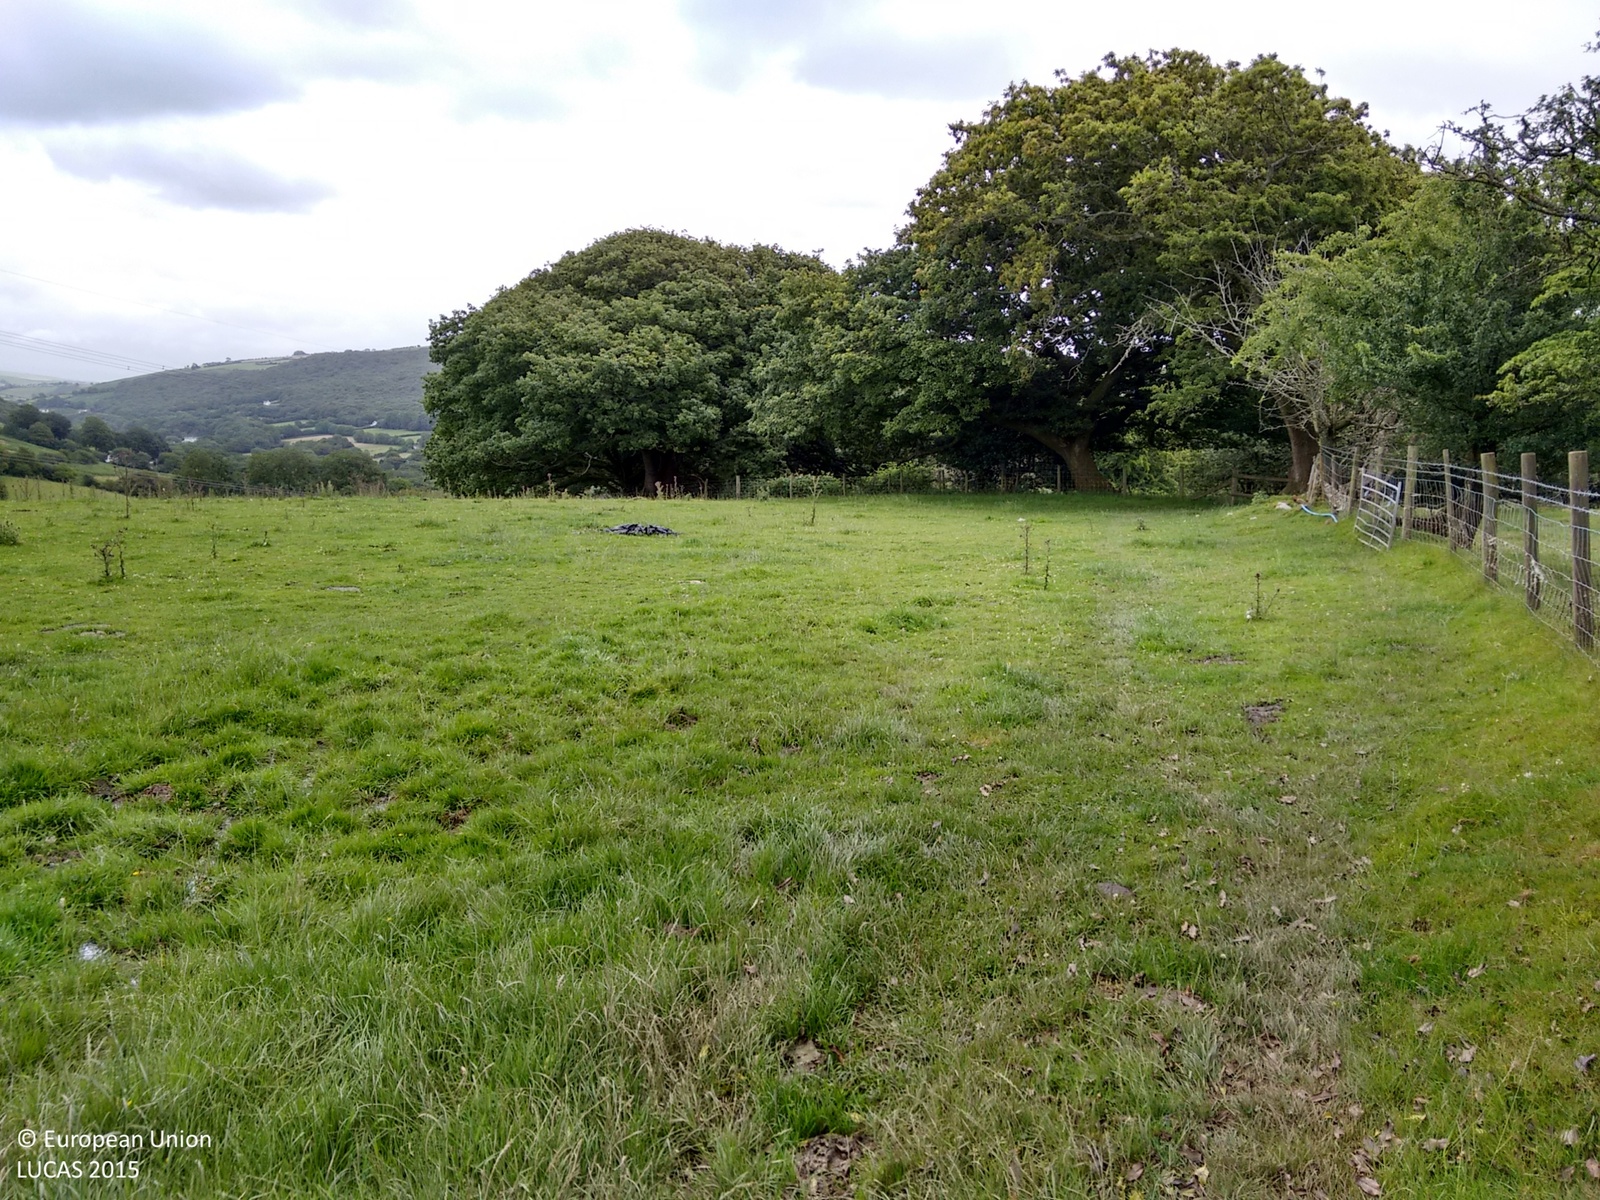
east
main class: Grassland
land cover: Grassland without tree/shrub cover
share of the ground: > 75 %
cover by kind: herbaceous plants 100 %
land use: Agriculture (excluding fallow land and kitchen gardens)
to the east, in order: Abandoned hedges; Fences; Grassland without tree/shrub cover; Fences; Broadleaved woodland; Fences; Broadleaved woodland; Grassland without tree/shrub cover; Fences; Broadleaved woodland
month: July
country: GB
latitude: 51.5568
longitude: -3.5718
